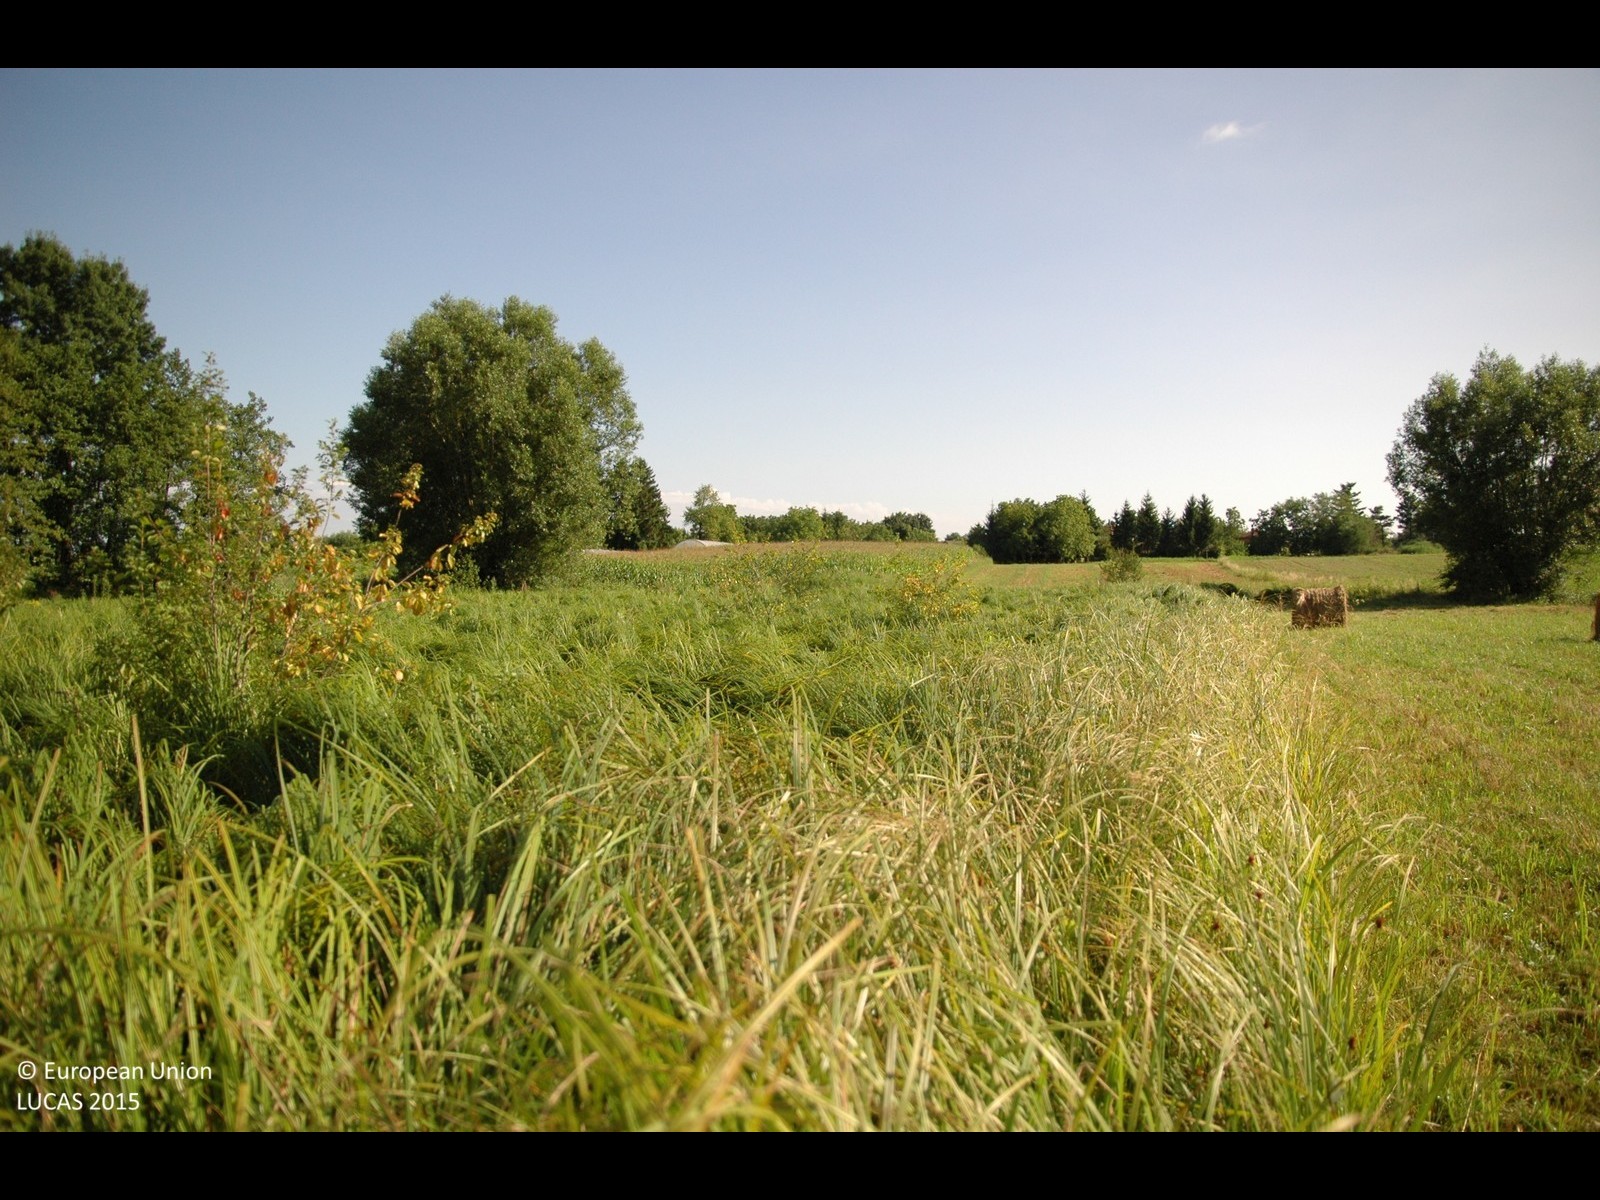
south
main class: Grassland
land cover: Grassland without tree/shrub cover
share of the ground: > 75 %
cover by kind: herbaceous plants 100 %
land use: Agriculture (excluding fallow land and kitchen gardens)
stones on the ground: < 10 %
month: July
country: HR
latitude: 46.2295
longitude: 16.7305
